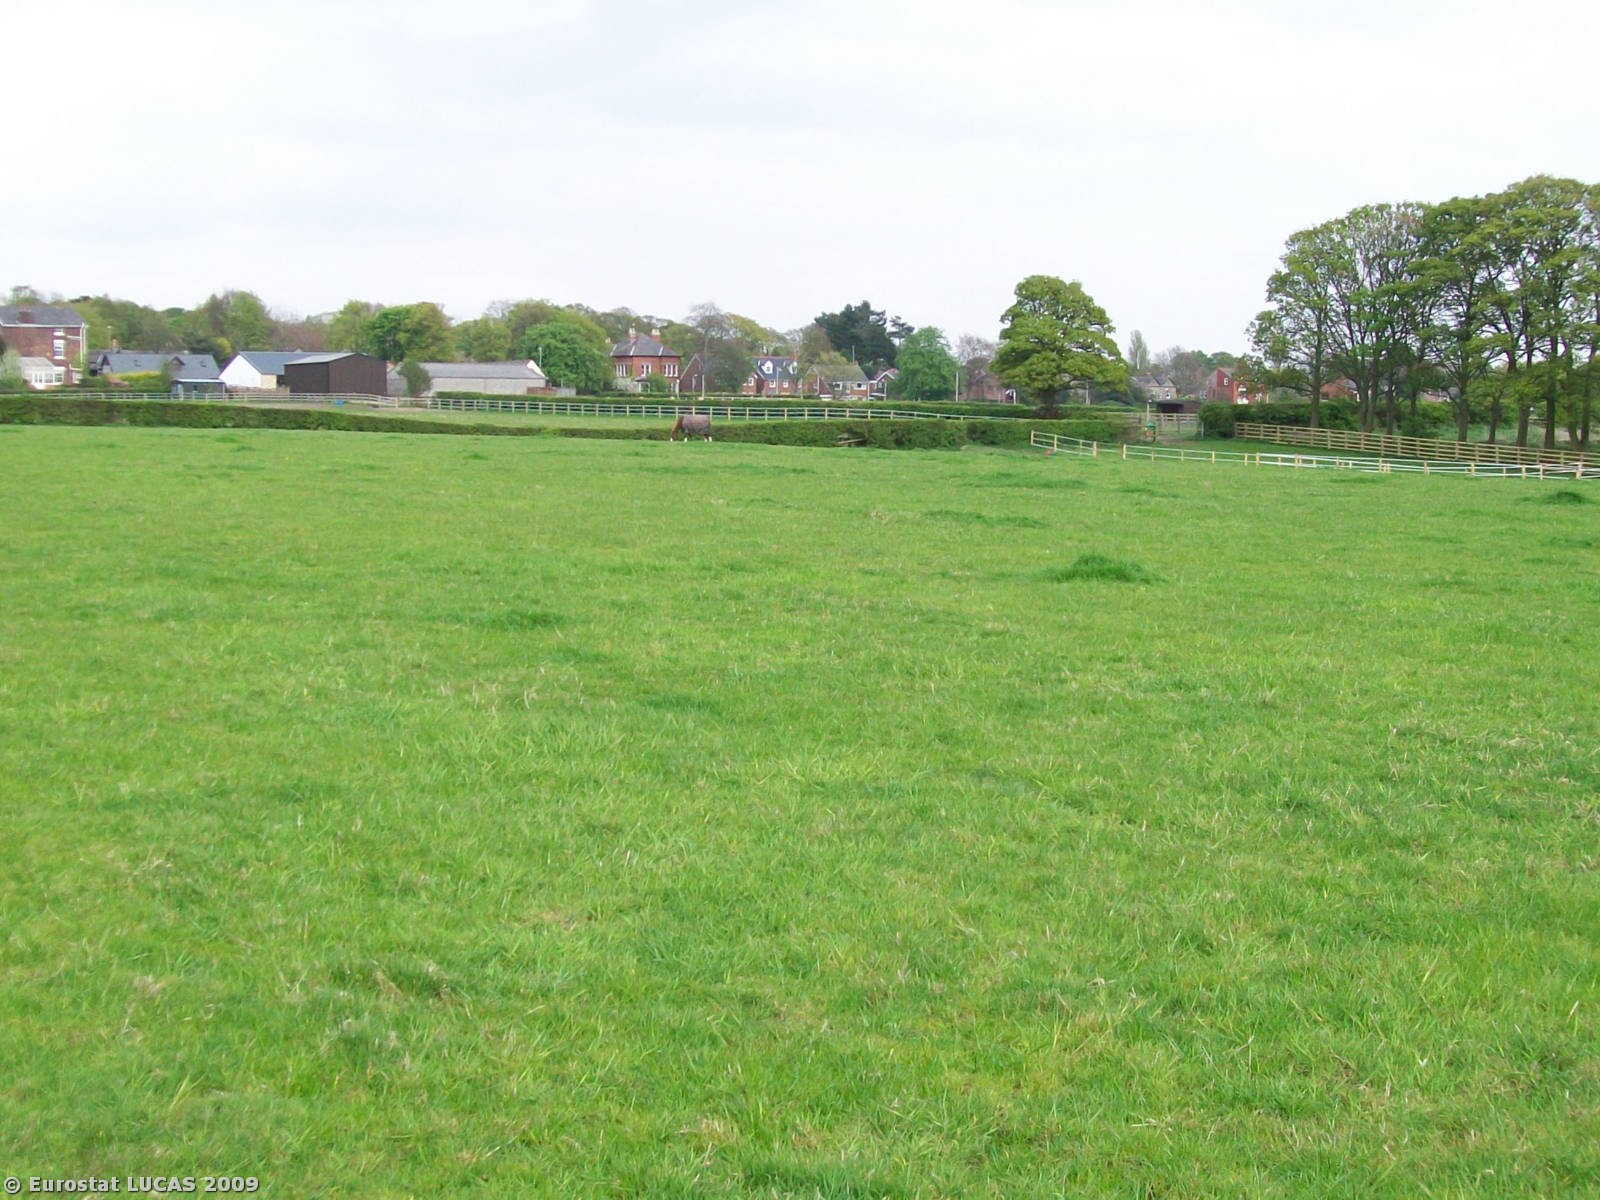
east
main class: Grassland
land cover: Grassland without tree/shrub cover
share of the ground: 50 - 75 %
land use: Agriculture (excluding fallow land and kitchen gardens)
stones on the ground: < 10 %
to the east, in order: Grassland without tree/shrub cover; Fences; Grassland without tree/shrub cover; Fences; Bare land; Fences; Grassland without tree/shrub cover; Fences; Grassland without tree/shrub cover; Fences; Grassland without tree/shrub cover
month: April
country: GB
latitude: 53.5447
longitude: -2.9153
